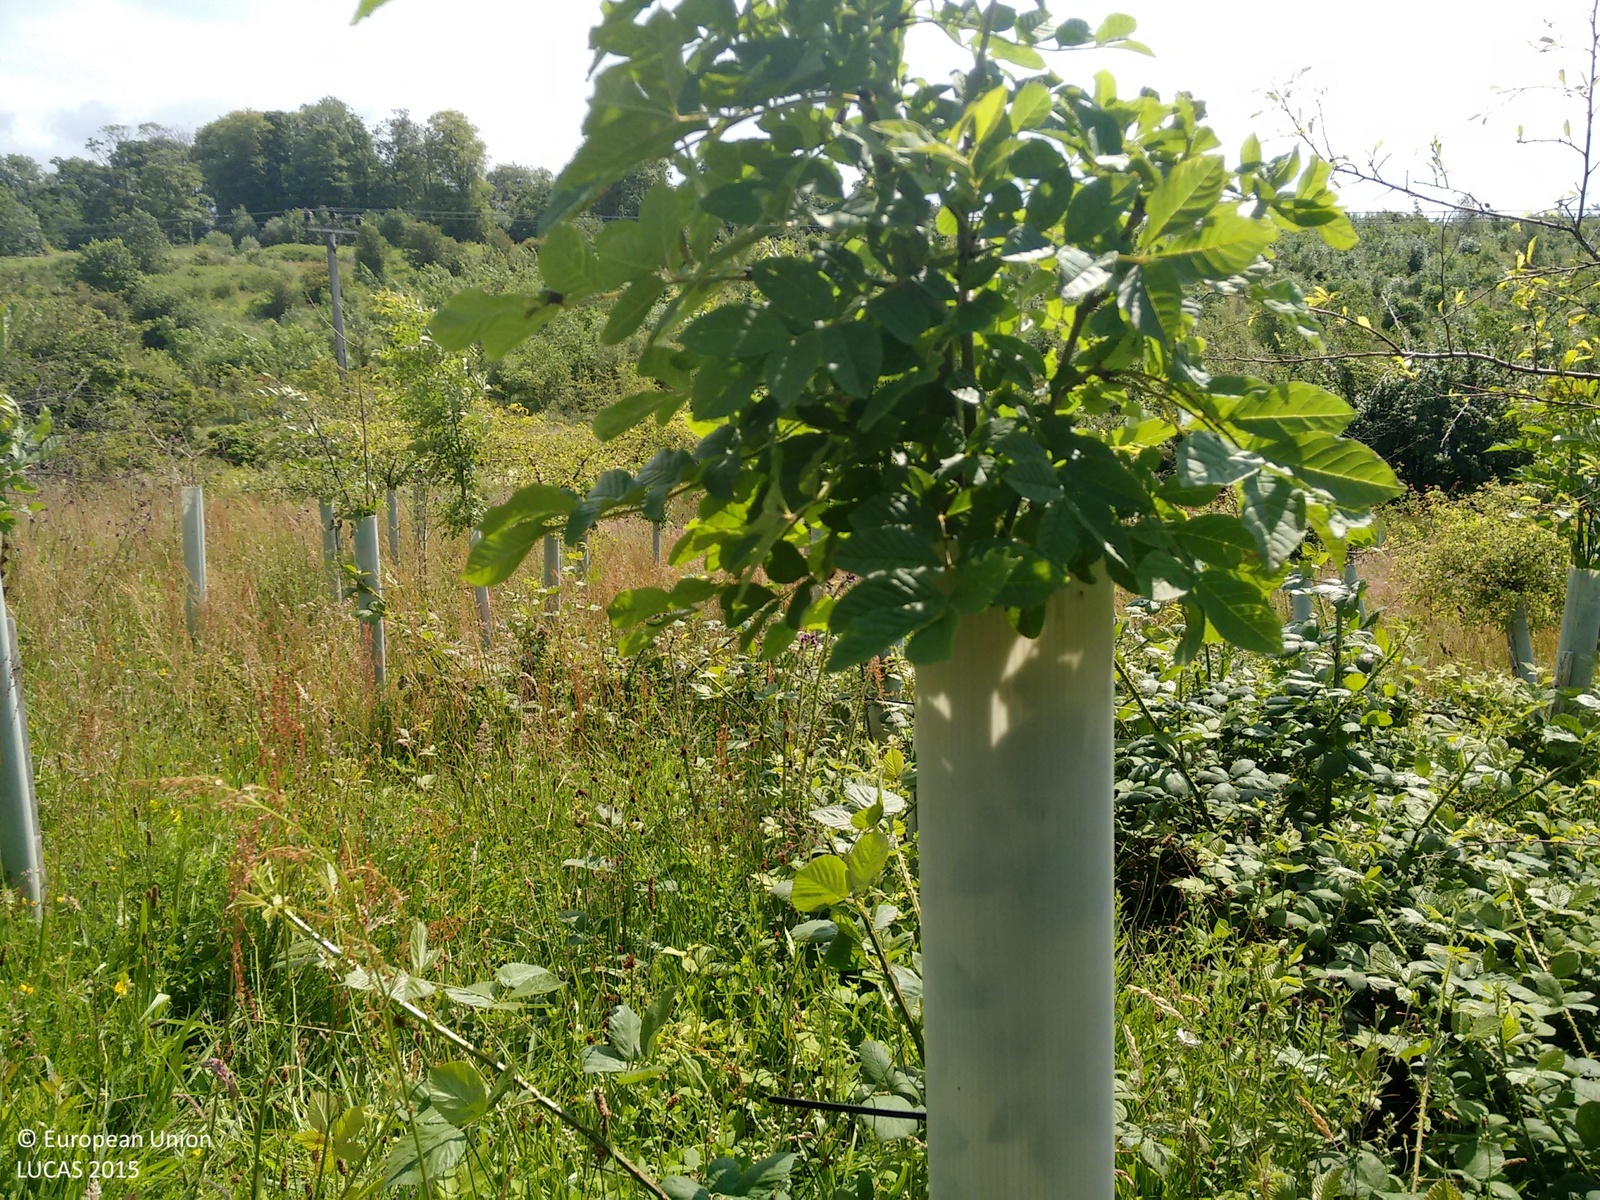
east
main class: Woodland
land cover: Broadleaved woodland
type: mesophytic deciduous forest
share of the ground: 50 - 75 %
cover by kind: broadleaved forest trees 70 %, herbaceous plants 20 %, lichens and mosses 10 %
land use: Forestry
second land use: Amenities, museums, leisure
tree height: < 5 m
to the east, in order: Broadleaved woodland; Grass margins; Ditches and canals; Abandoned hedges; Grass margins; Electric lines; Grass margins; Tracks; Grassland without tree/shrub cover; Ditches and canals; Grass margins; Tracks; Grass margins; Broadleaved woodland; Grass margins; Tracks; Grass margins; Ditches and canals; Grass margins; Abandoned hedges; Fences; Tracks; Grass margins; Broadleaved woodland
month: July
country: GB
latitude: 55.7152
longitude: -4.7330
